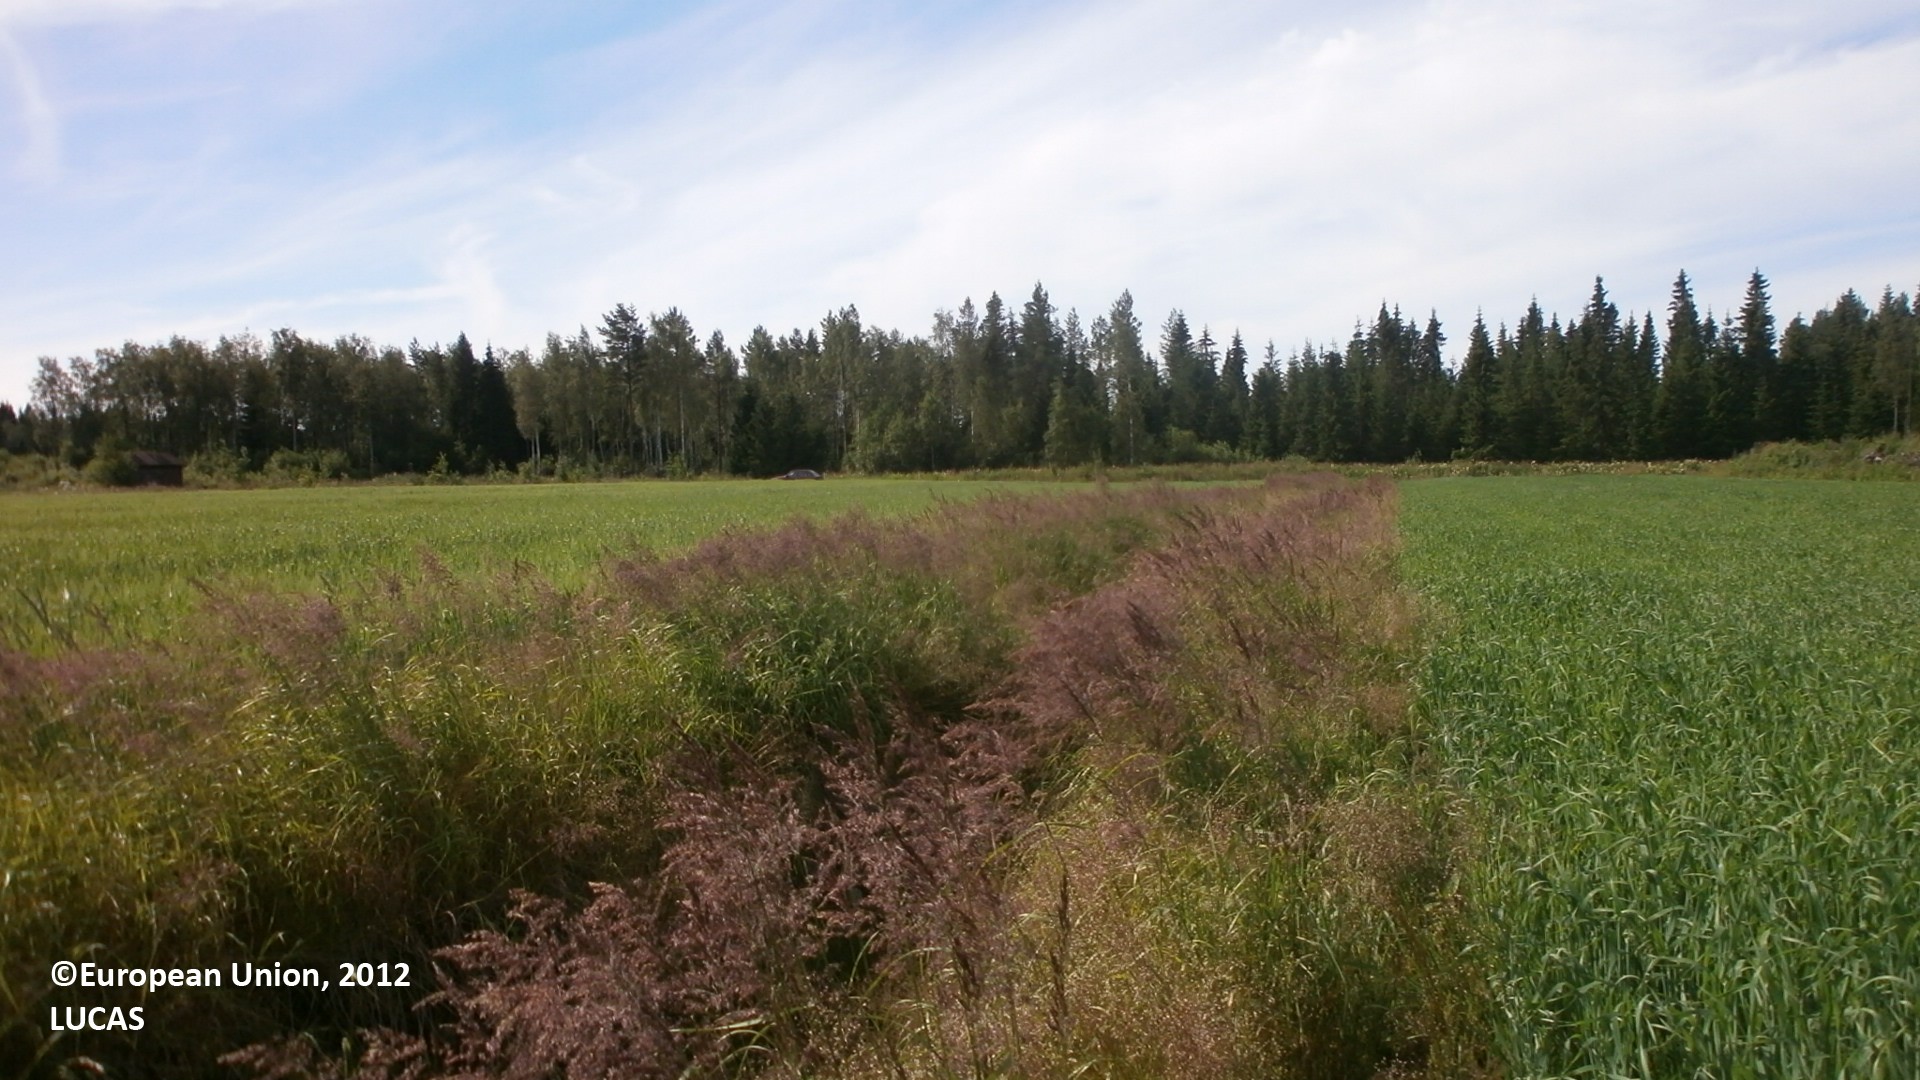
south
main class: Cropland
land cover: Oats
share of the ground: > 75 %
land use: Agriculture (excluding fallow land and kitchen gardens)
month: July
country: FI
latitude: 64.4007
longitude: 24.1907
